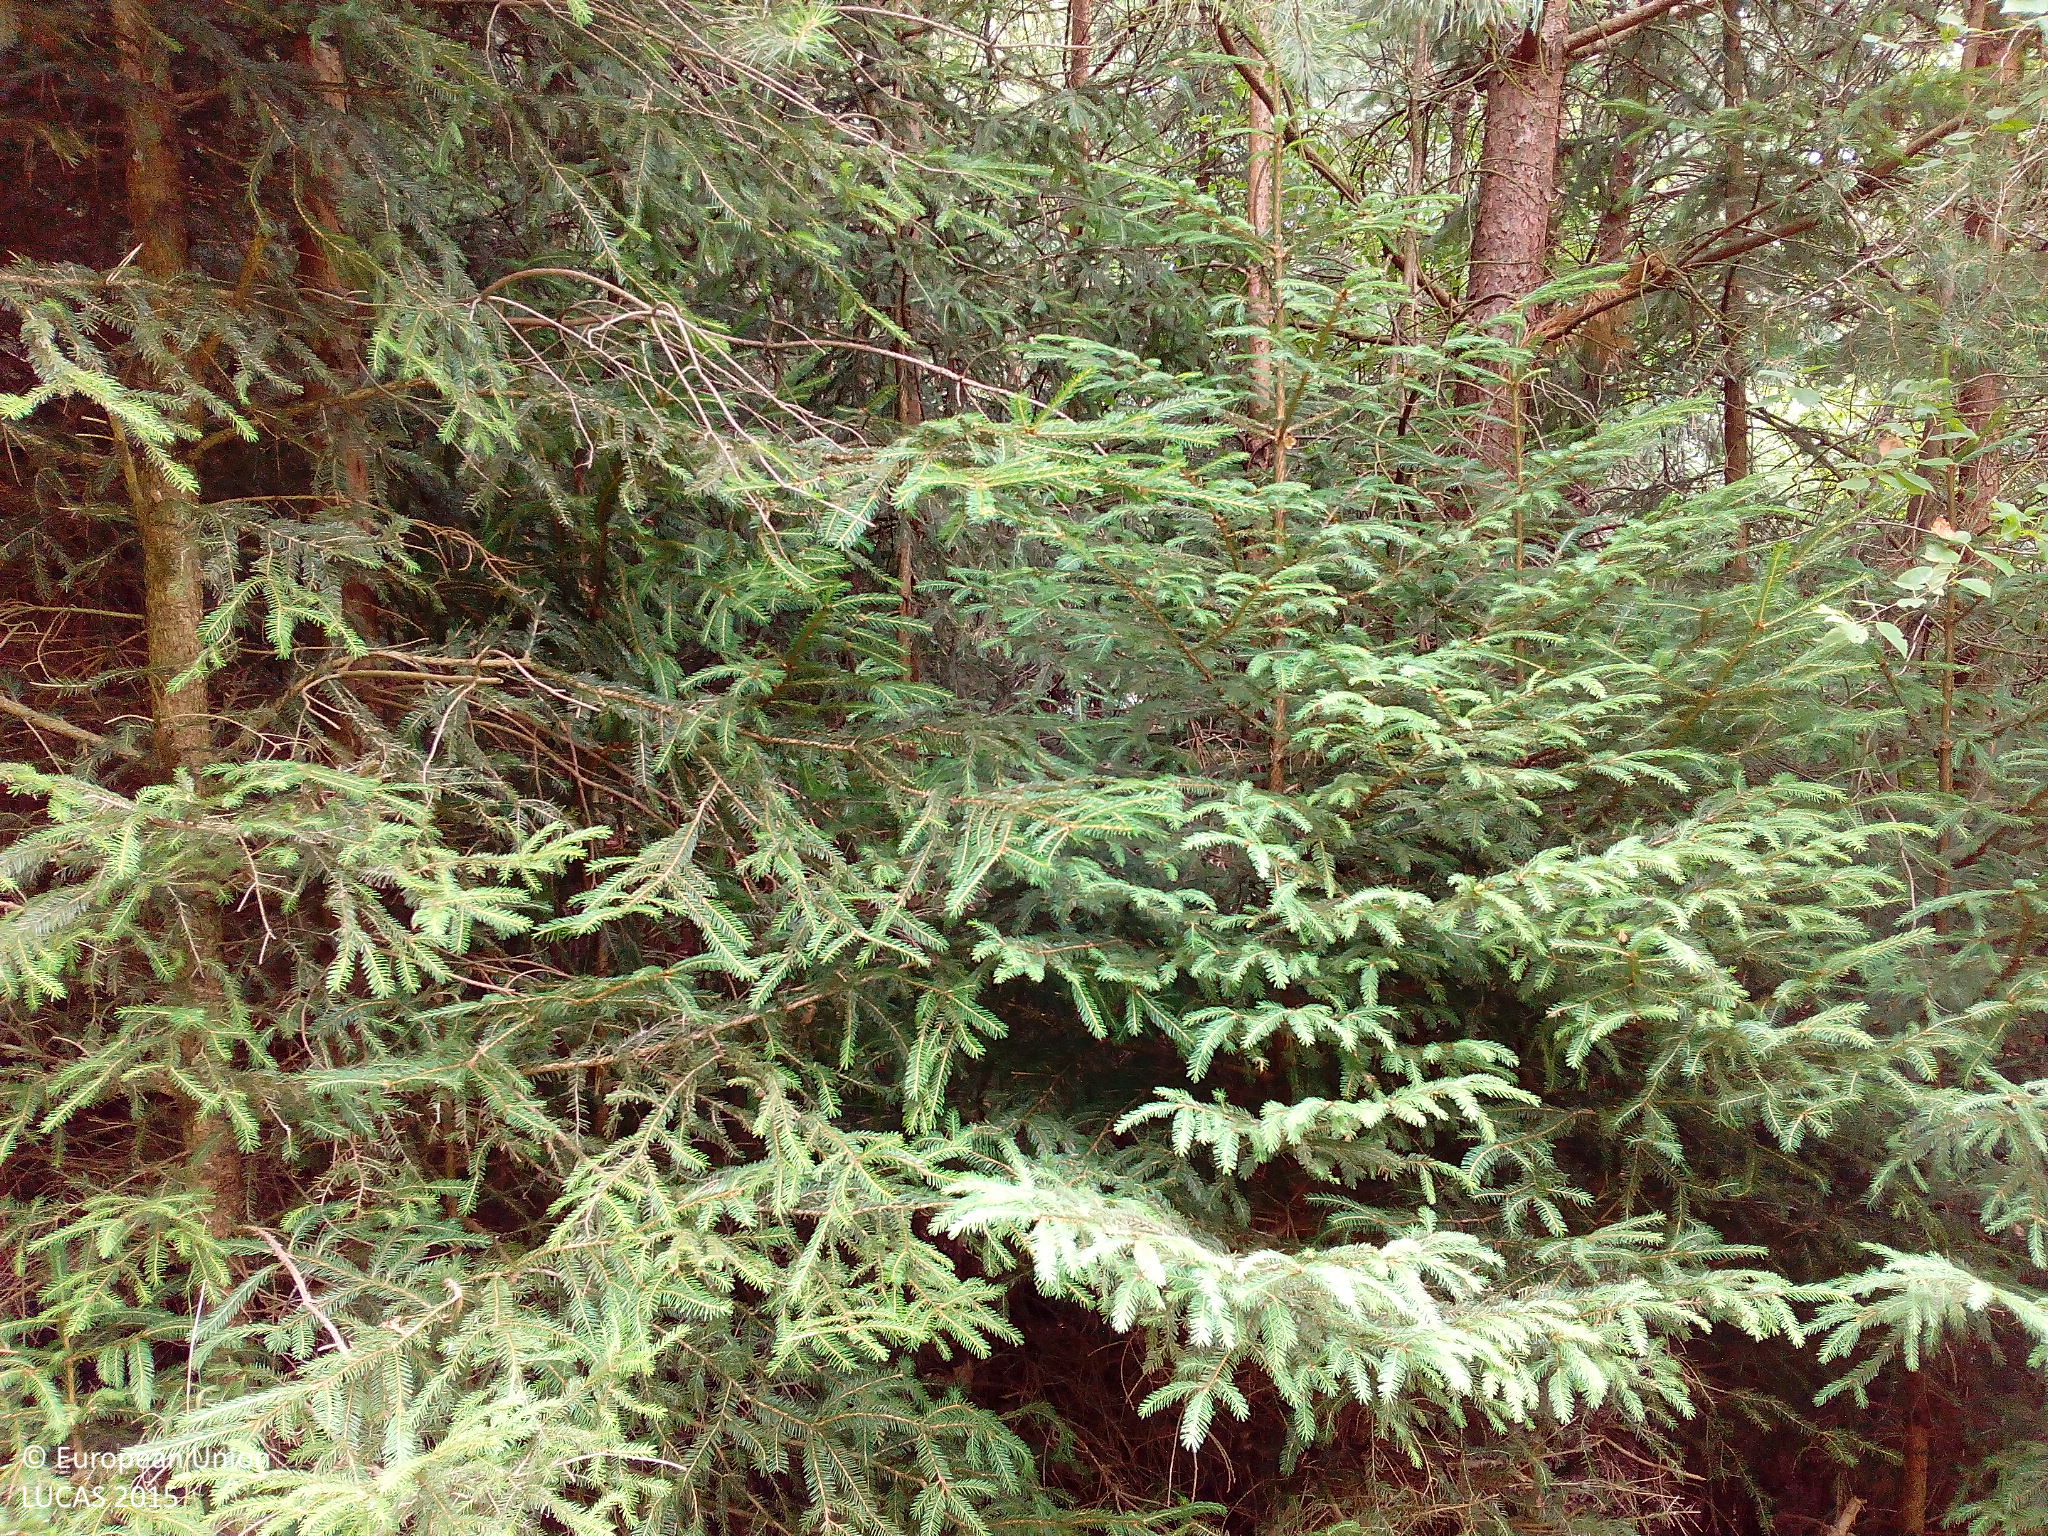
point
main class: Woodland
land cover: Spruce dominated mixed woodland
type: hemiboreal forest and nemoral coniferous forest and mixed broadleaved-coniferous forest
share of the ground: > 75 %
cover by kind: coniferous forest trees 60 %, broadleaved forest trees 40 %
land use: Forestry
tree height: > 5 m
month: July
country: DE
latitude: 50.8135
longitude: 9.9574
